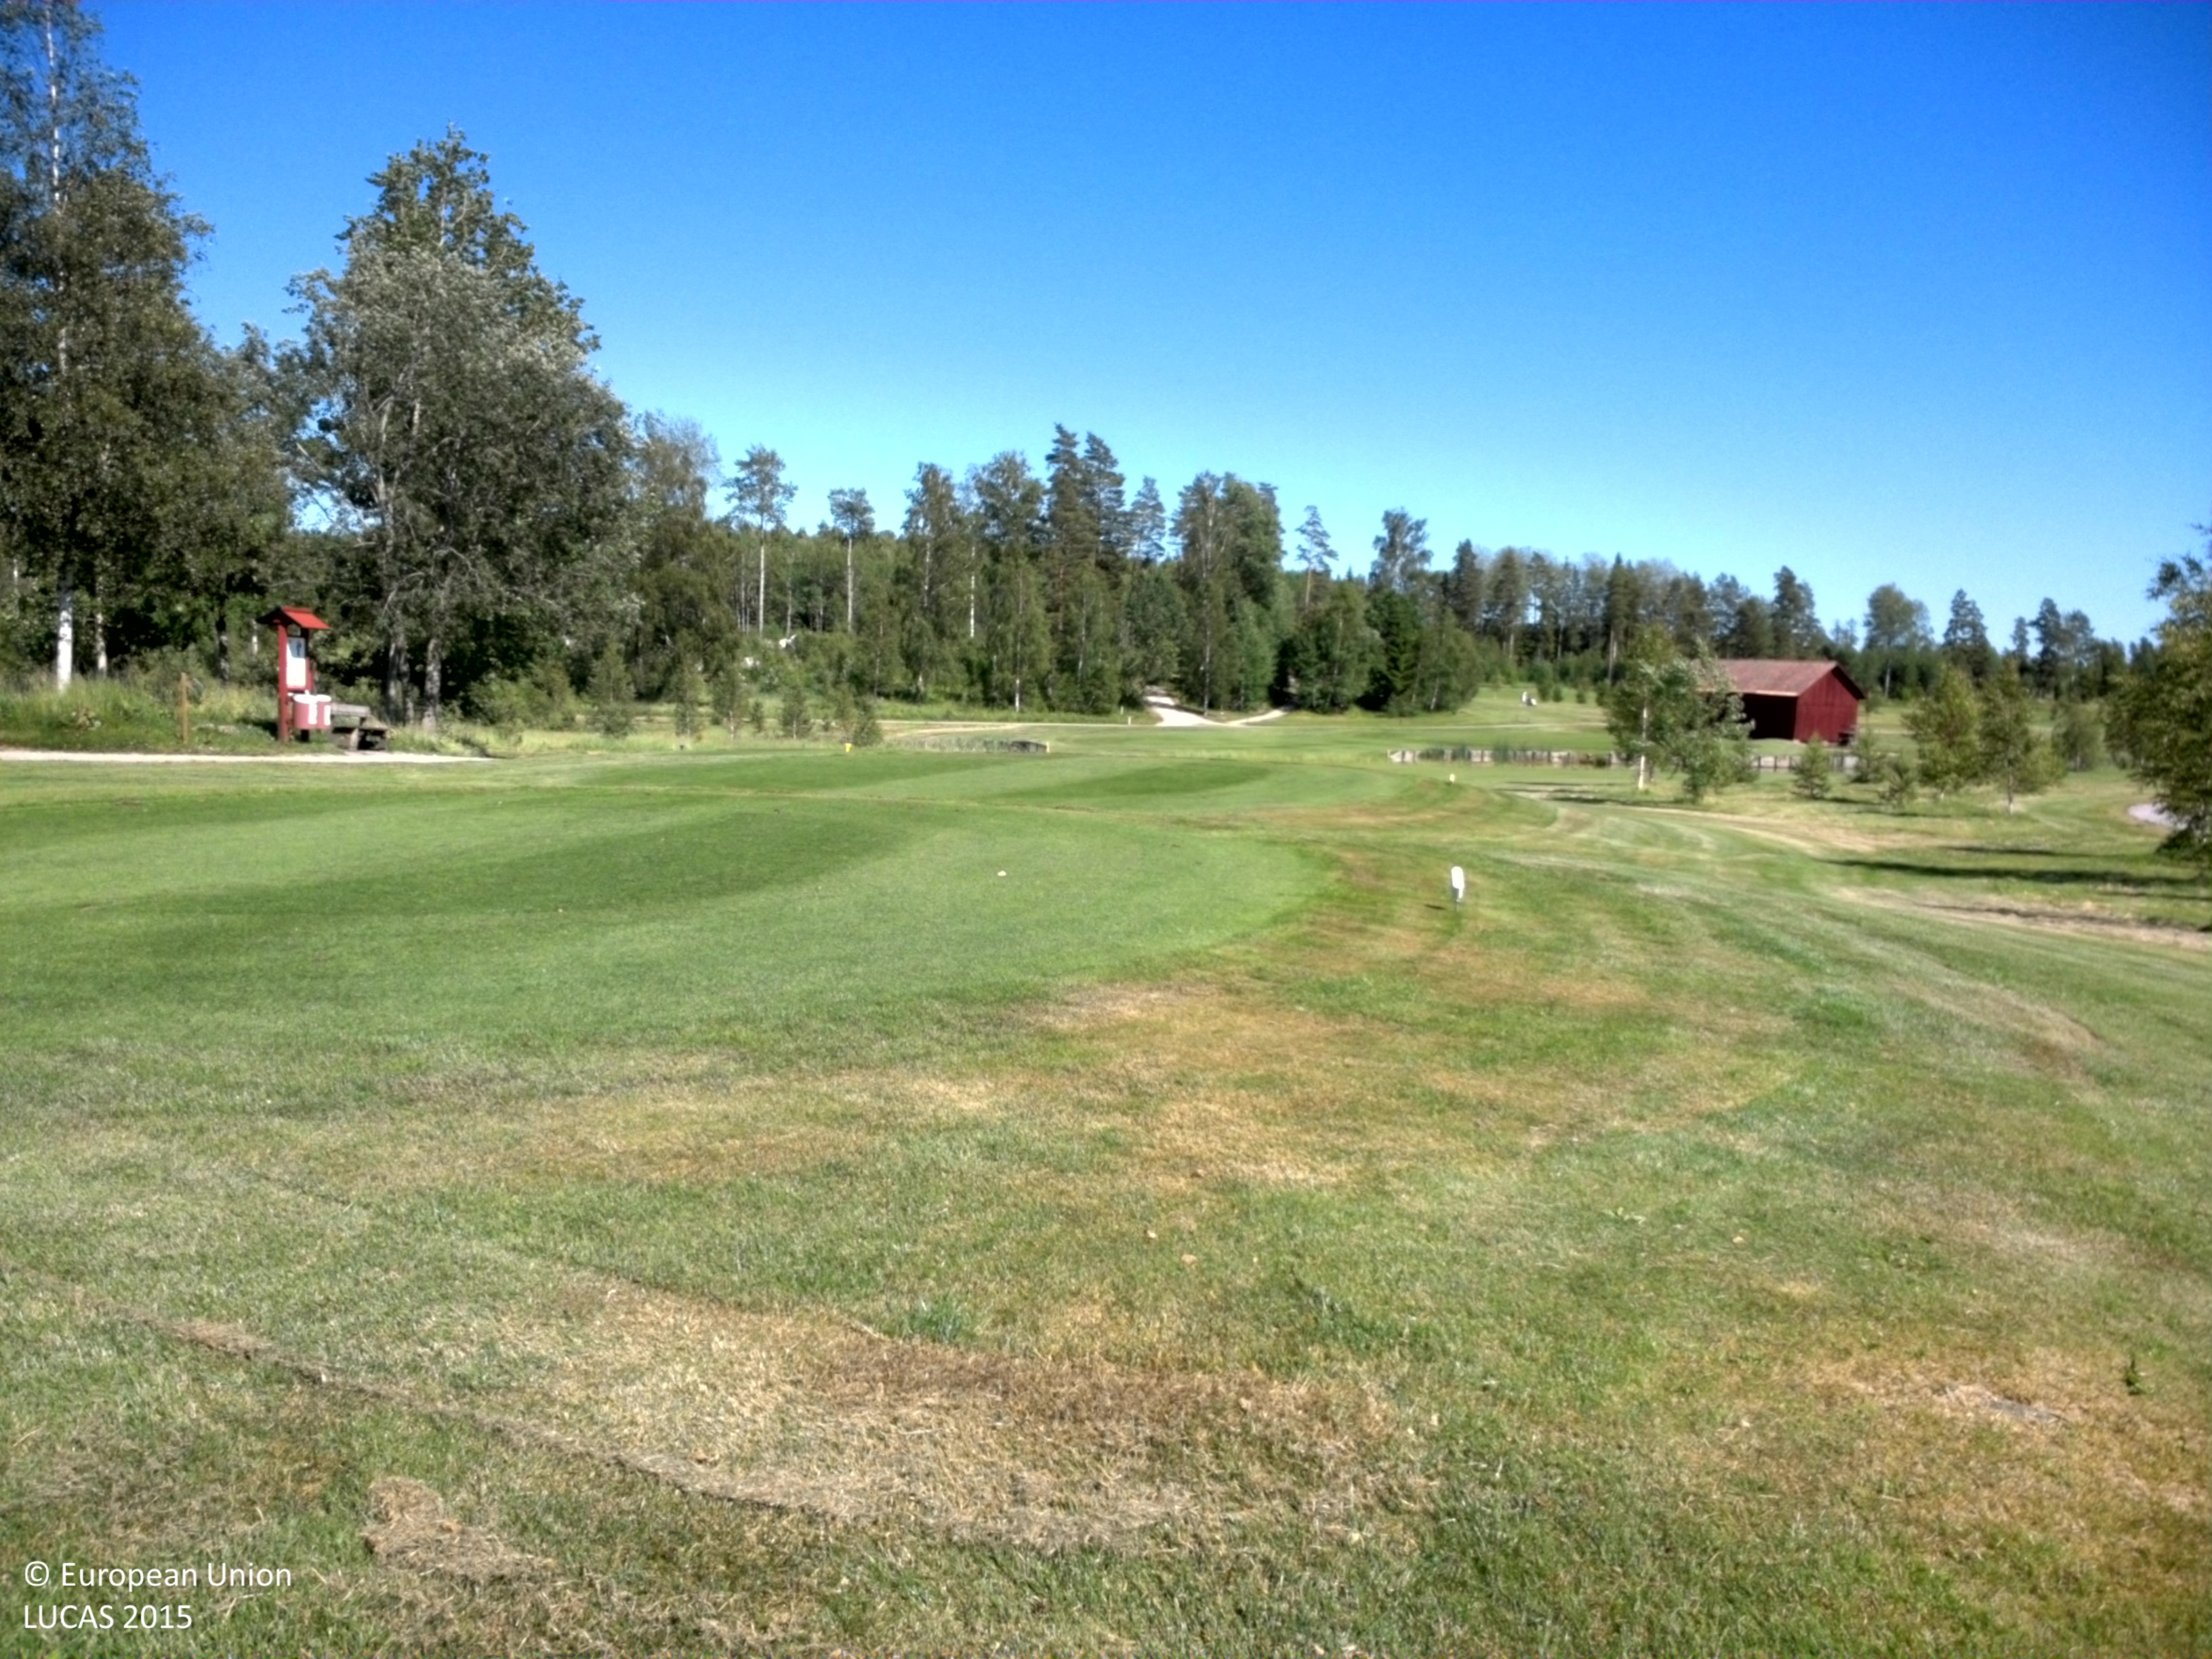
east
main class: Grassland
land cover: Grassland without tree/shrub cover
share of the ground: > 75 %
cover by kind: herbaceous plants 100 %
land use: Sport
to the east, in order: Grassland without tree/shrub cover; Ditches and canals; Grassland without tree/shrub cover; Tracks; Grass margins; Ditches and canals; Broadleaved woodland; Grass margins; Tracks; Grassland without tree/shrub cover; Pine dominated mixed woodland; Grassland without tree/shrub cover
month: July
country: SE
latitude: 59.9489
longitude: 16.7047
